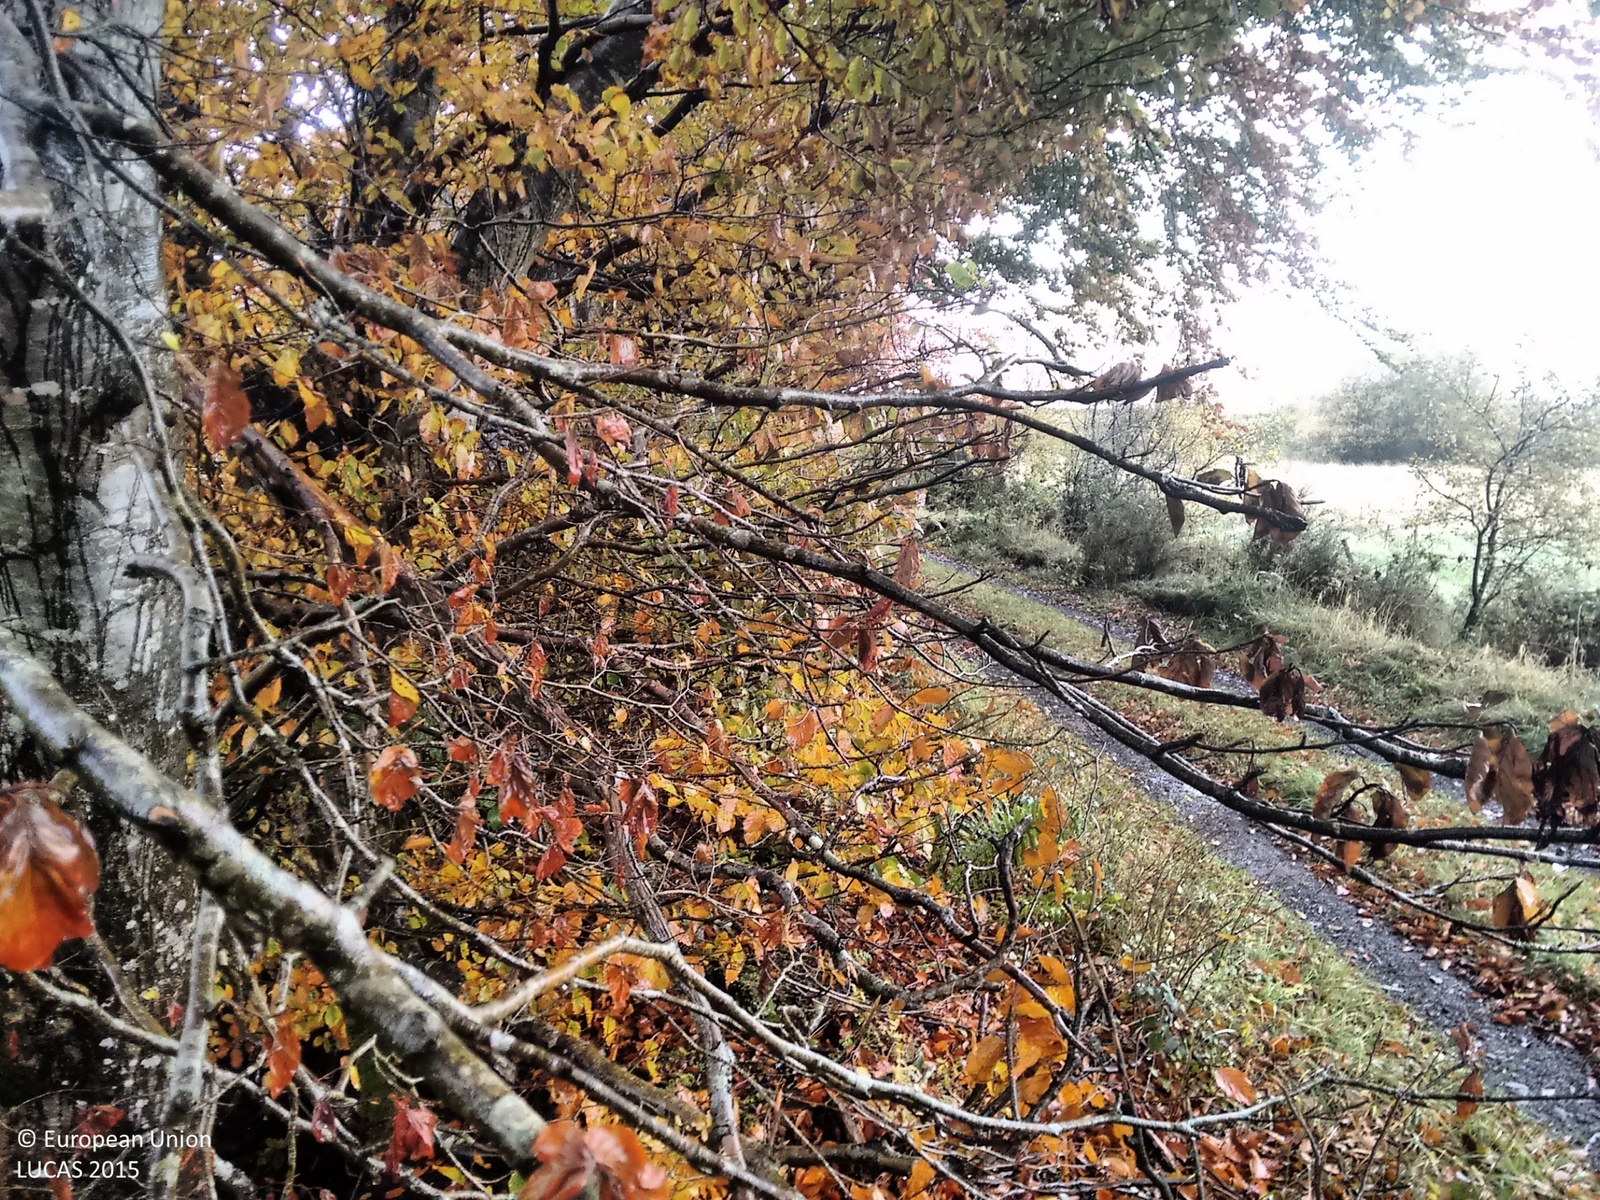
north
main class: Grassland
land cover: Grassland without tree/shrub cover
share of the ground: > 75 %
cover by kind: herbaceous plants 100 %
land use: Agriculture (excluding fallow land and kitchen gardens)
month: October
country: IE
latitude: 53.9301
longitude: -8.2935
